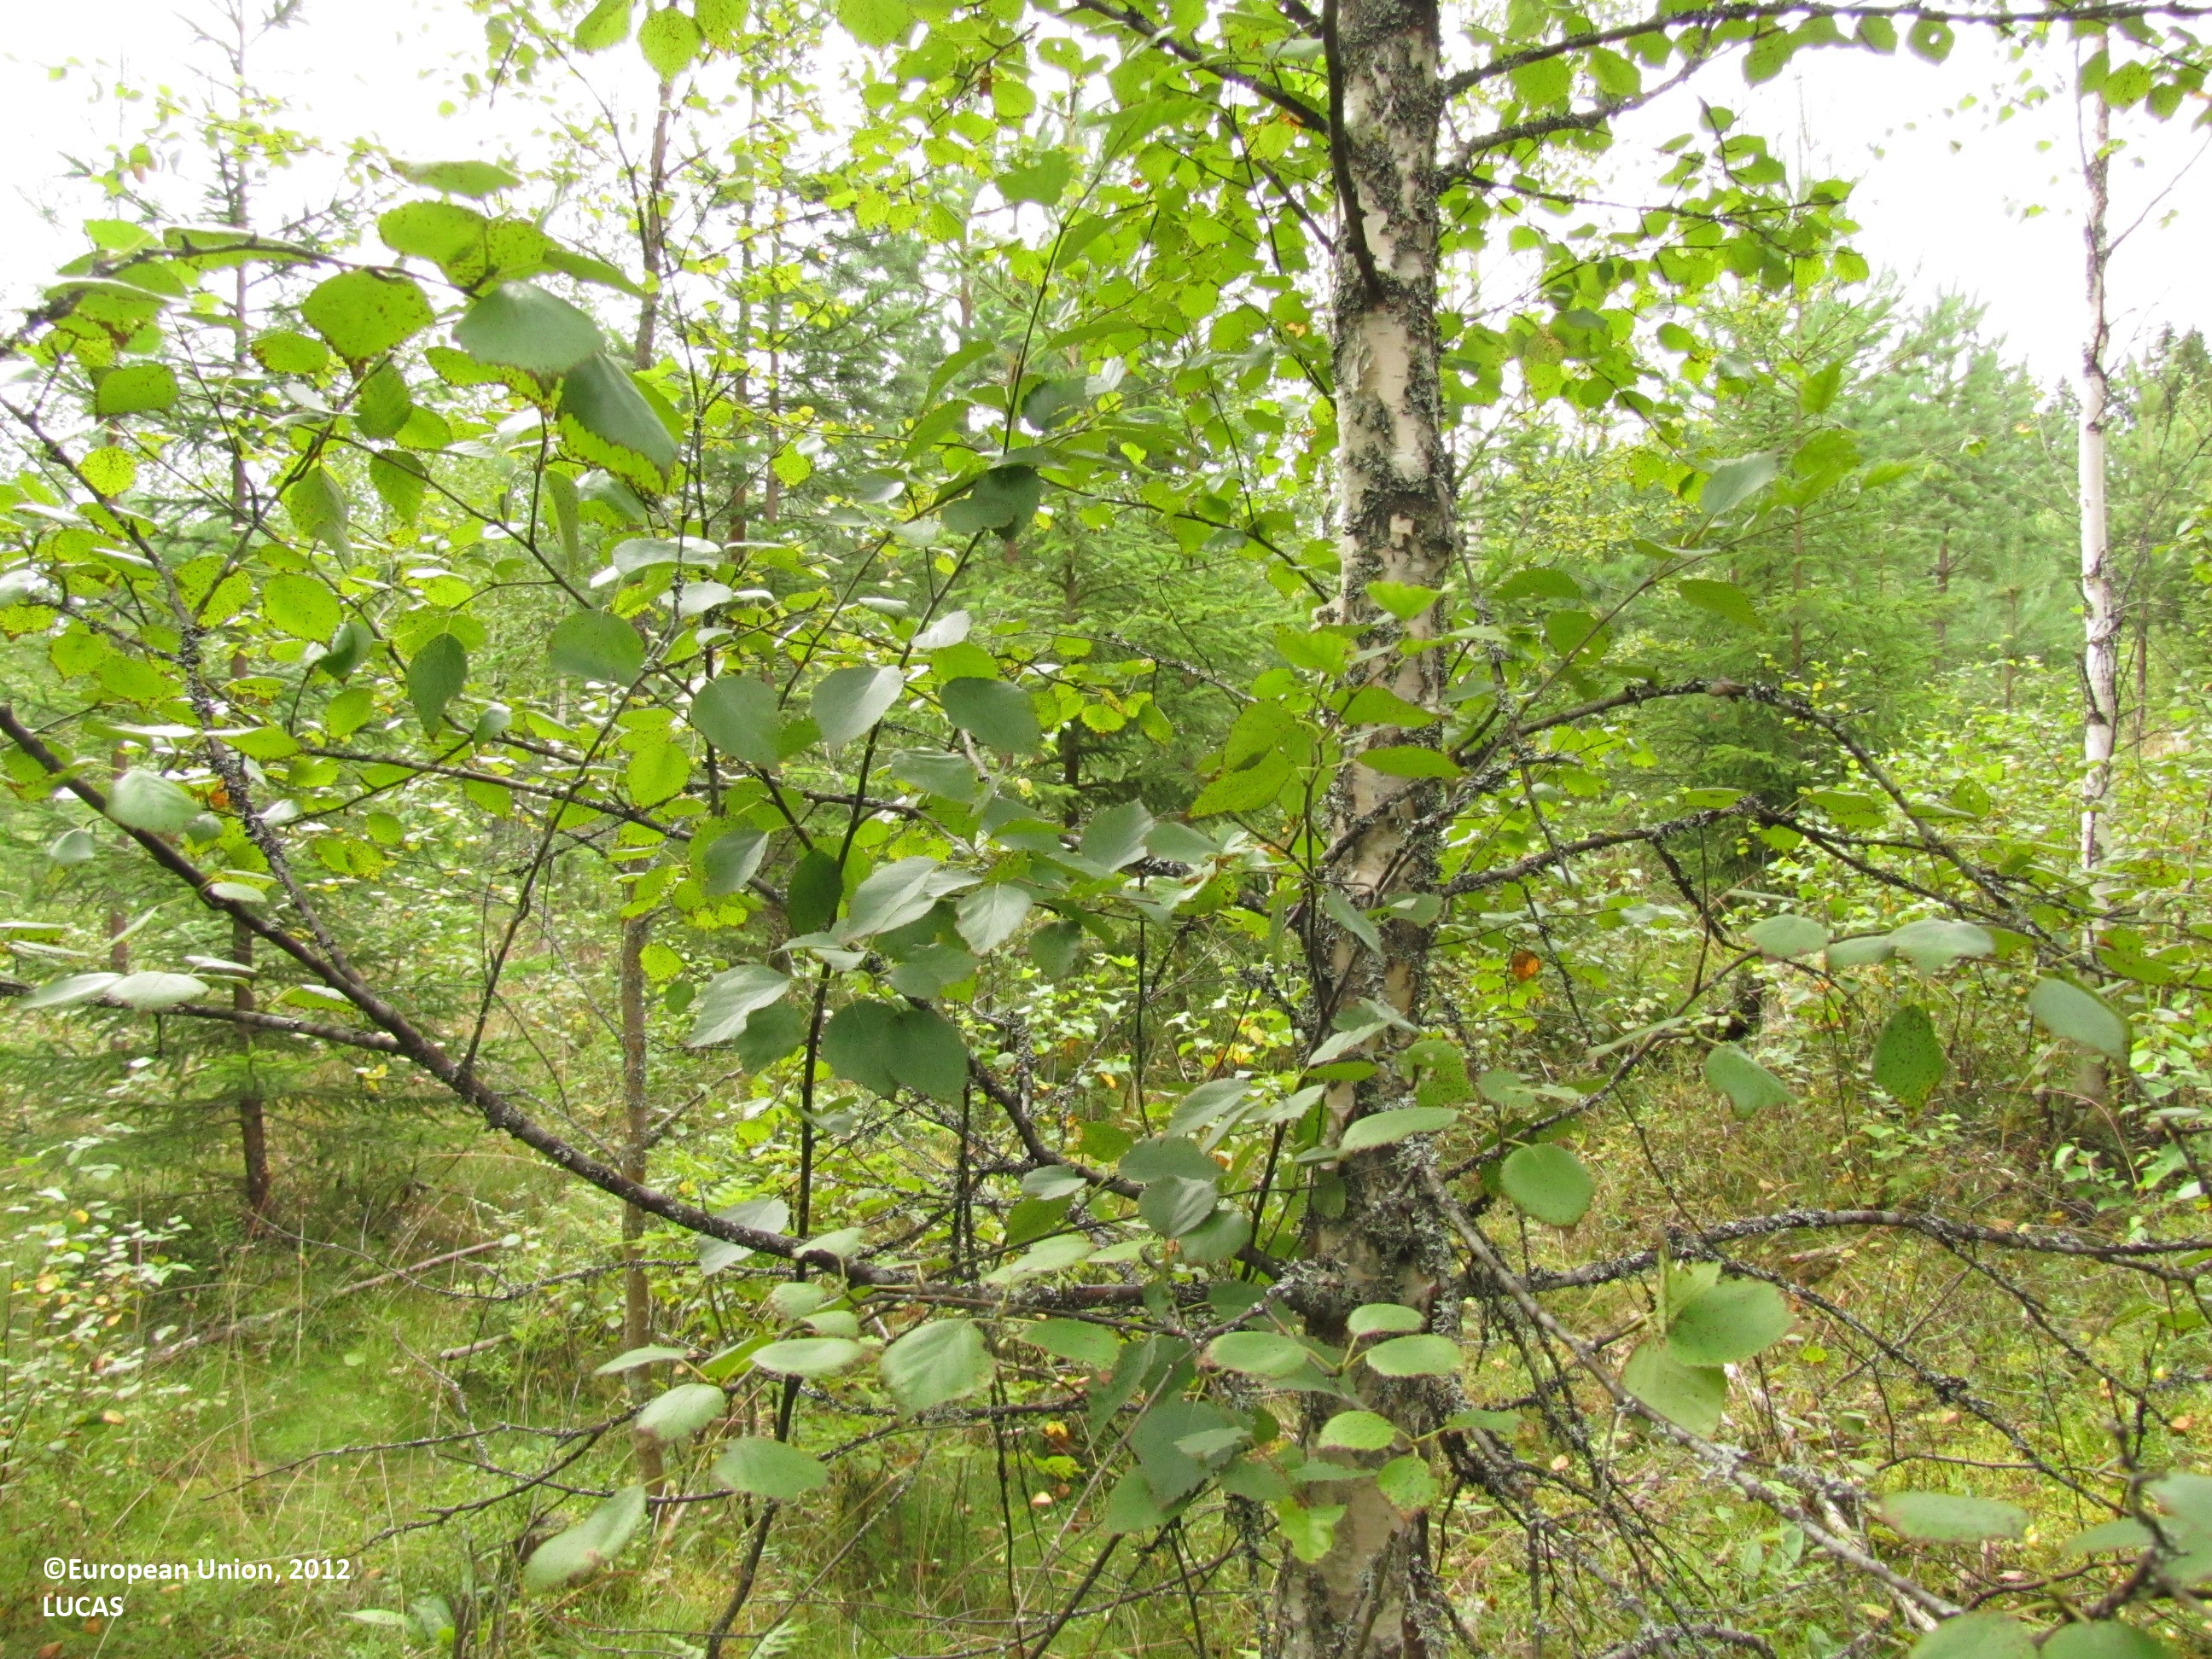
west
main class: Woodland
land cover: Pine dominated mixed woodland
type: boreal forest
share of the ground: 25 - 50 %
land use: Forestry
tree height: < 5 m
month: August
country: FI
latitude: 61.8692
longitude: 23.1318
